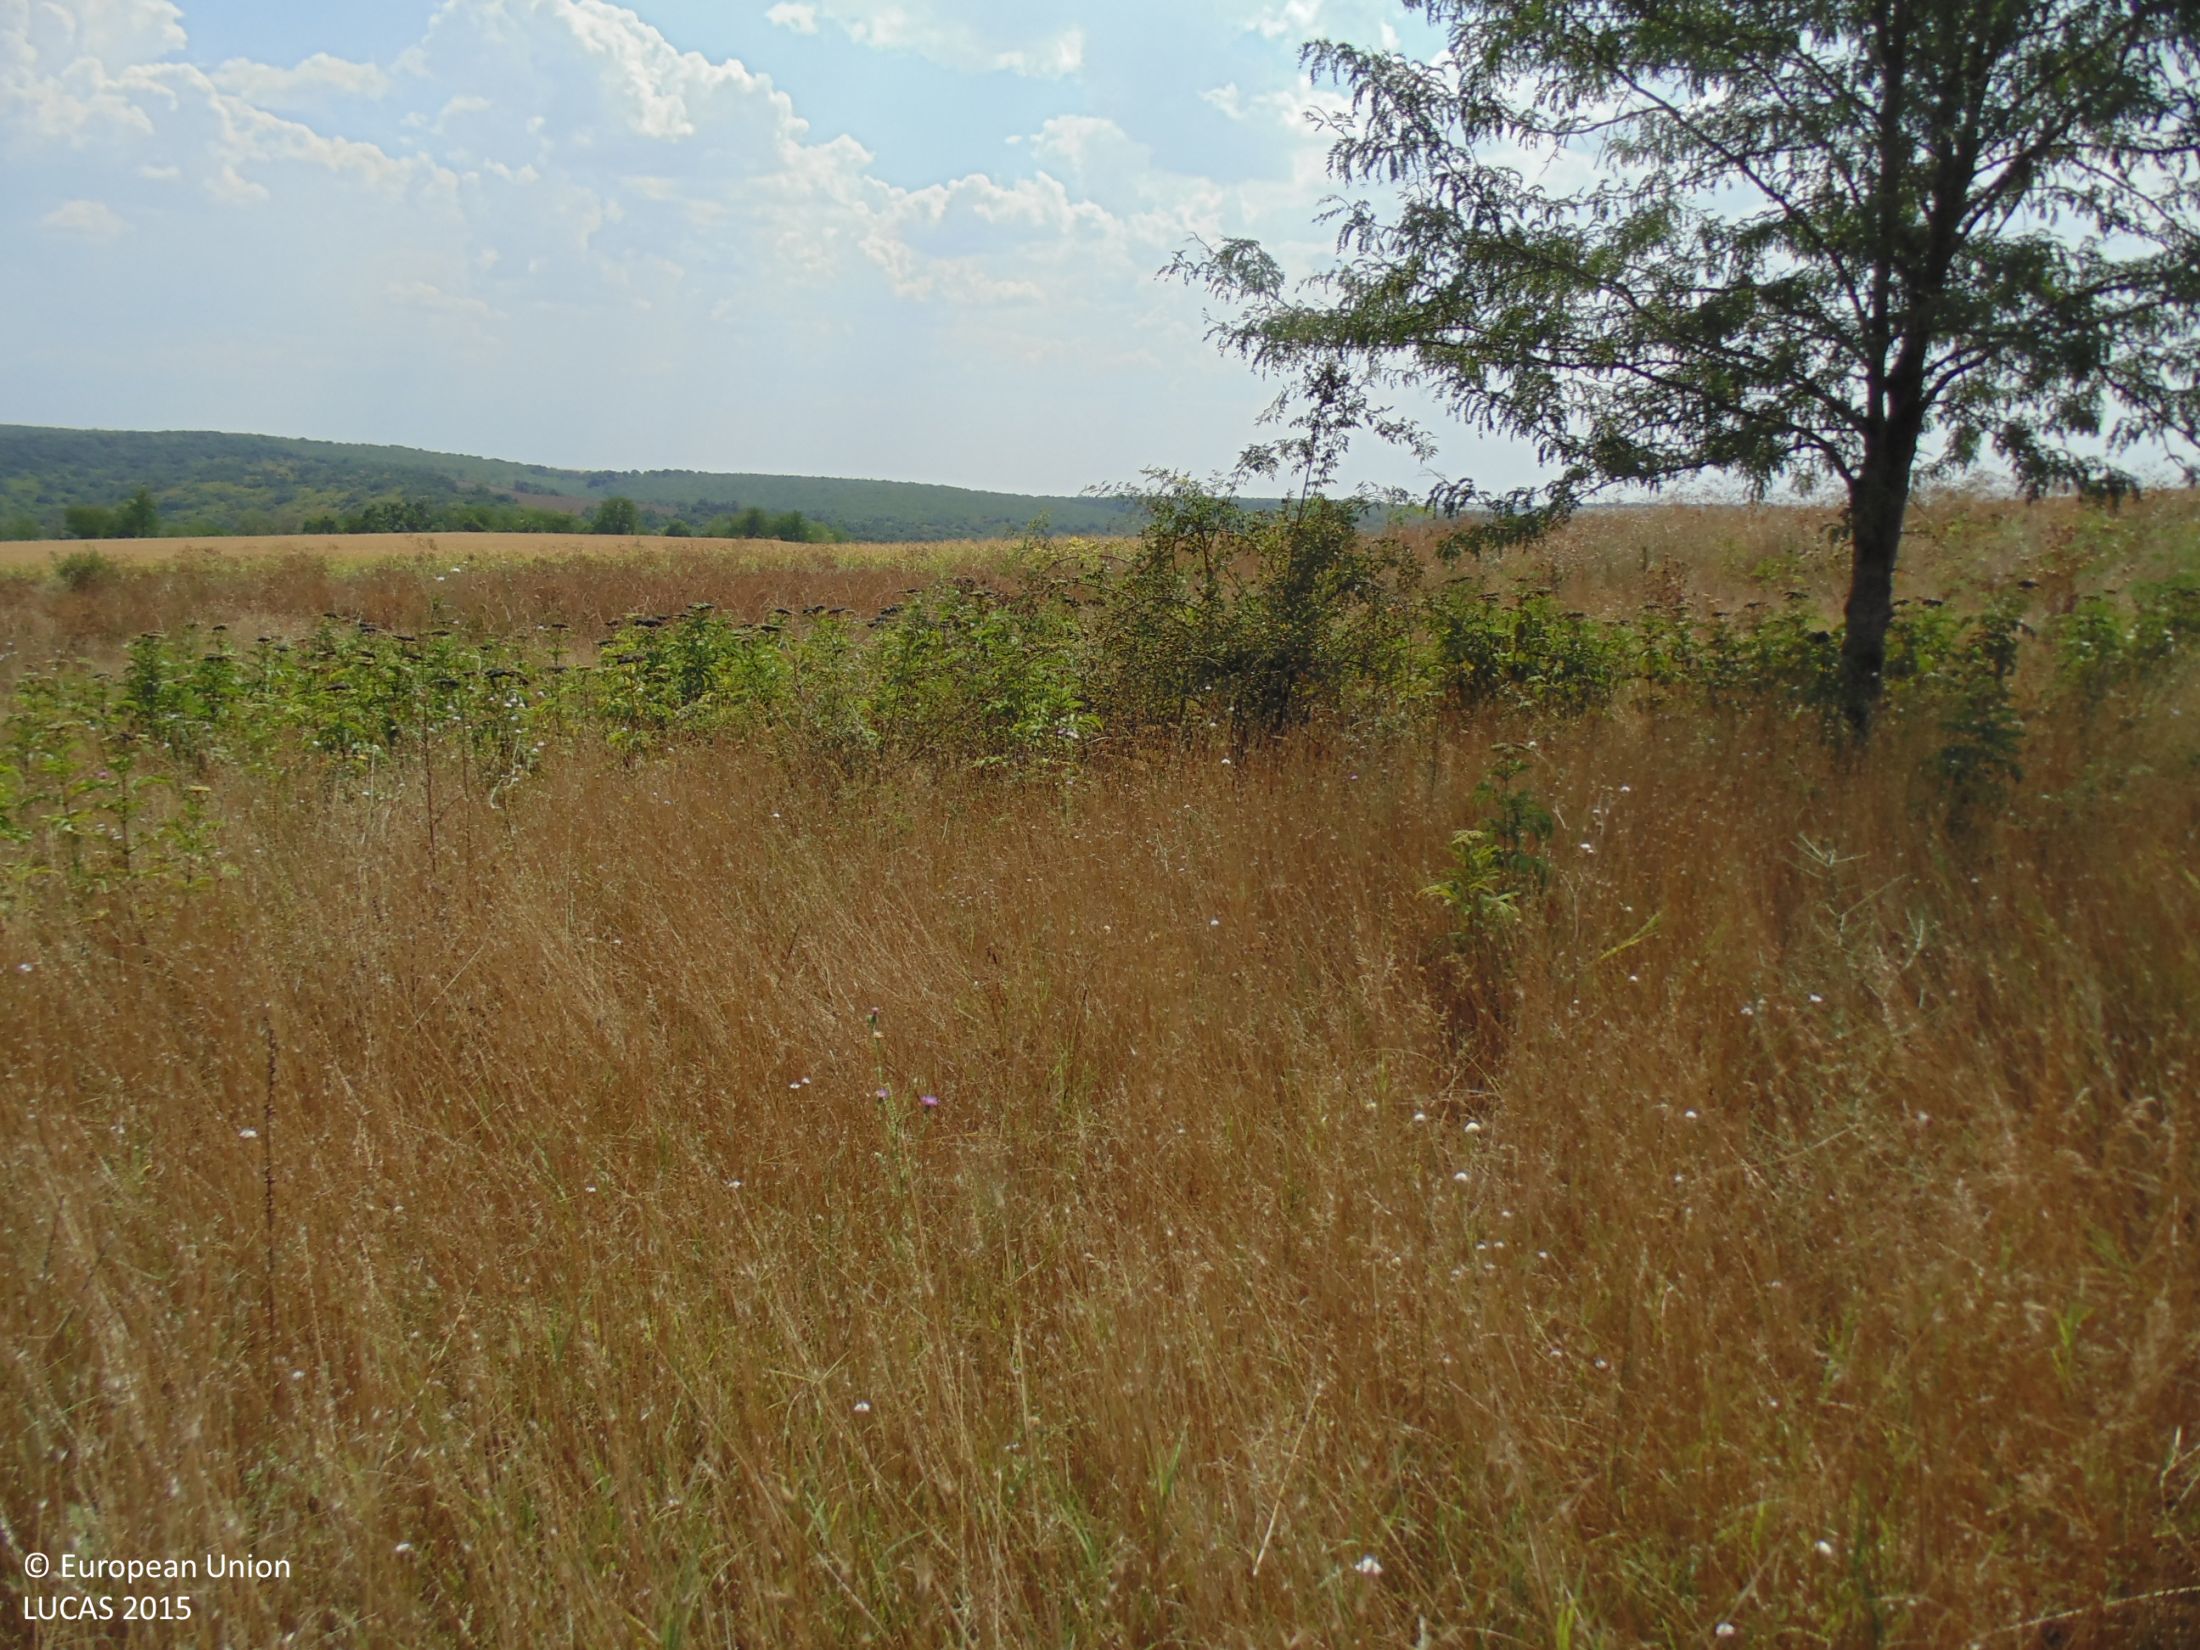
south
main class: Grassland
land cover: Grassland with sparse tree/shrub cover
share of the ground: > 75 %
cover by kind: herbaceous plants 90 %, broadleaved forest trees 5 %, shrubs 5 %
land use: Agriculture (excluding fallow land and kitchen gardens)
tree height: < 5 m
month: August
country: BG
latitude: 44.0043
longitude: 27.6391
